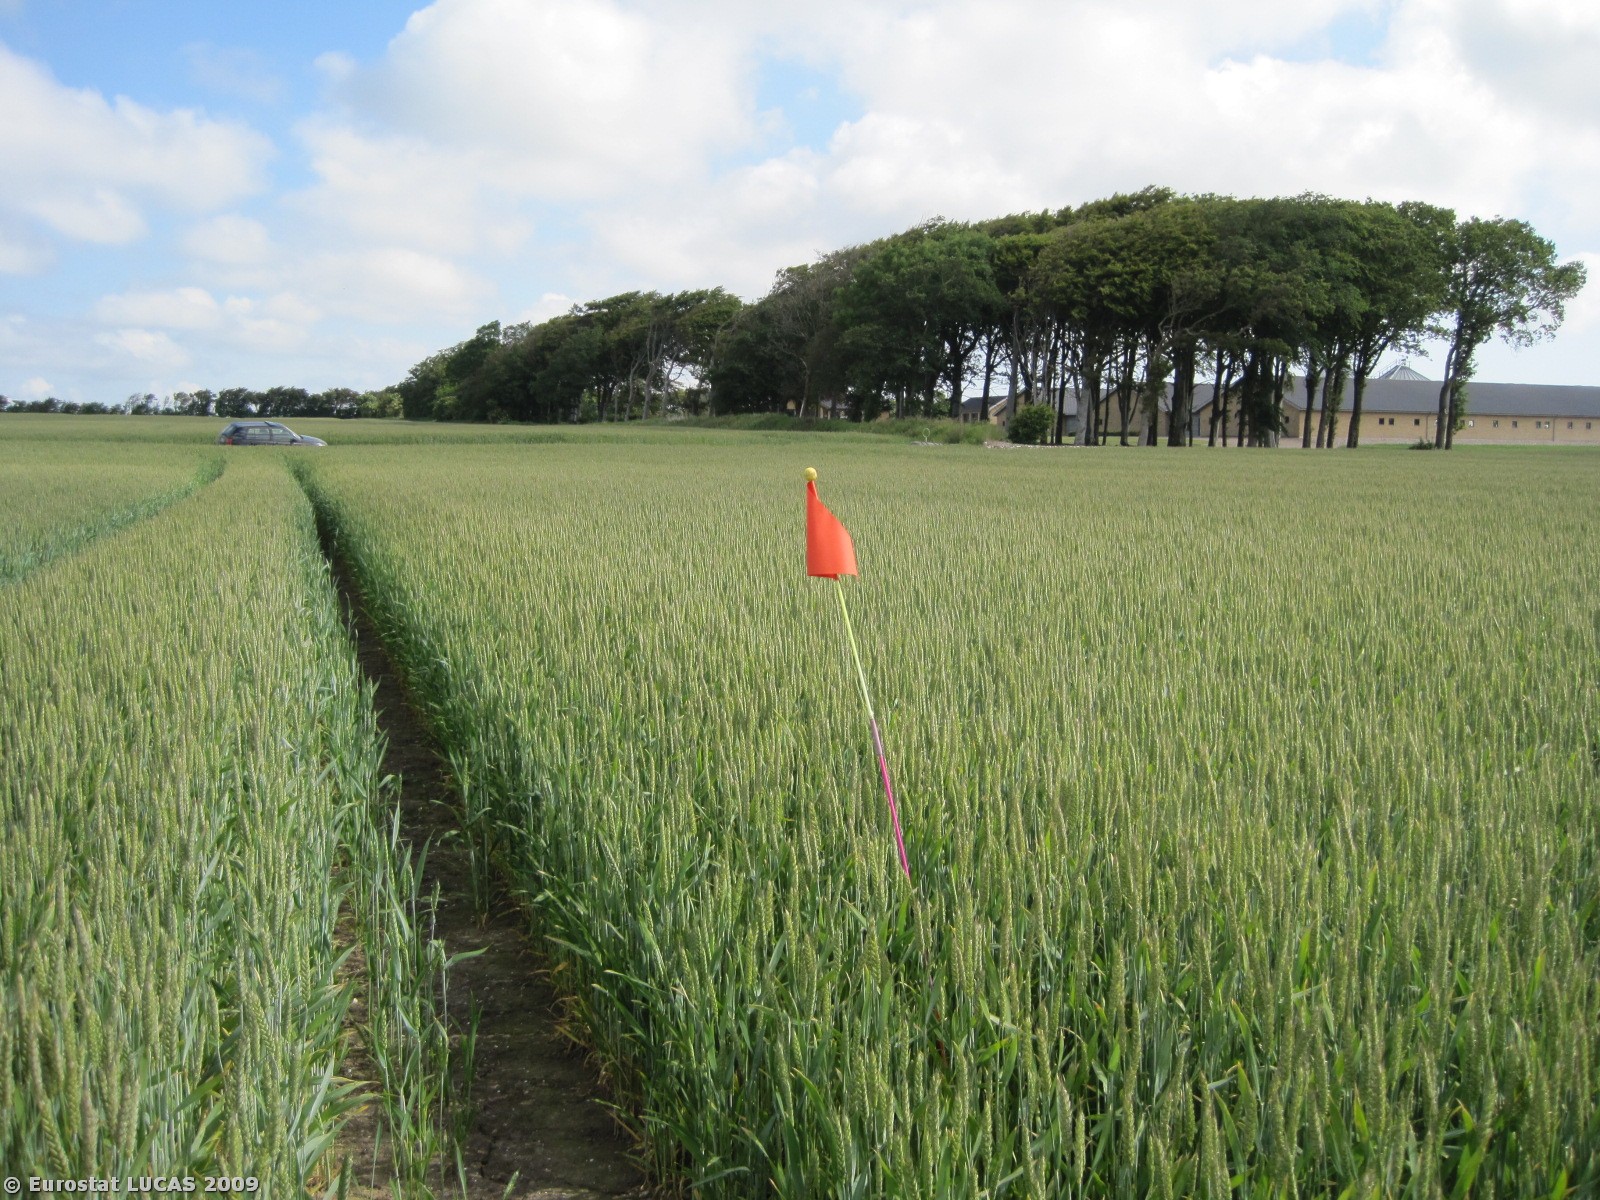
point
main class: Cropland
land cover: Common wheat
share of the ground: > 75 %
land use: Agriculture (excluding fallow land and kitchen gardens)
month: June
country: DK
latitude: 56.7749
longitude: 8.7417
